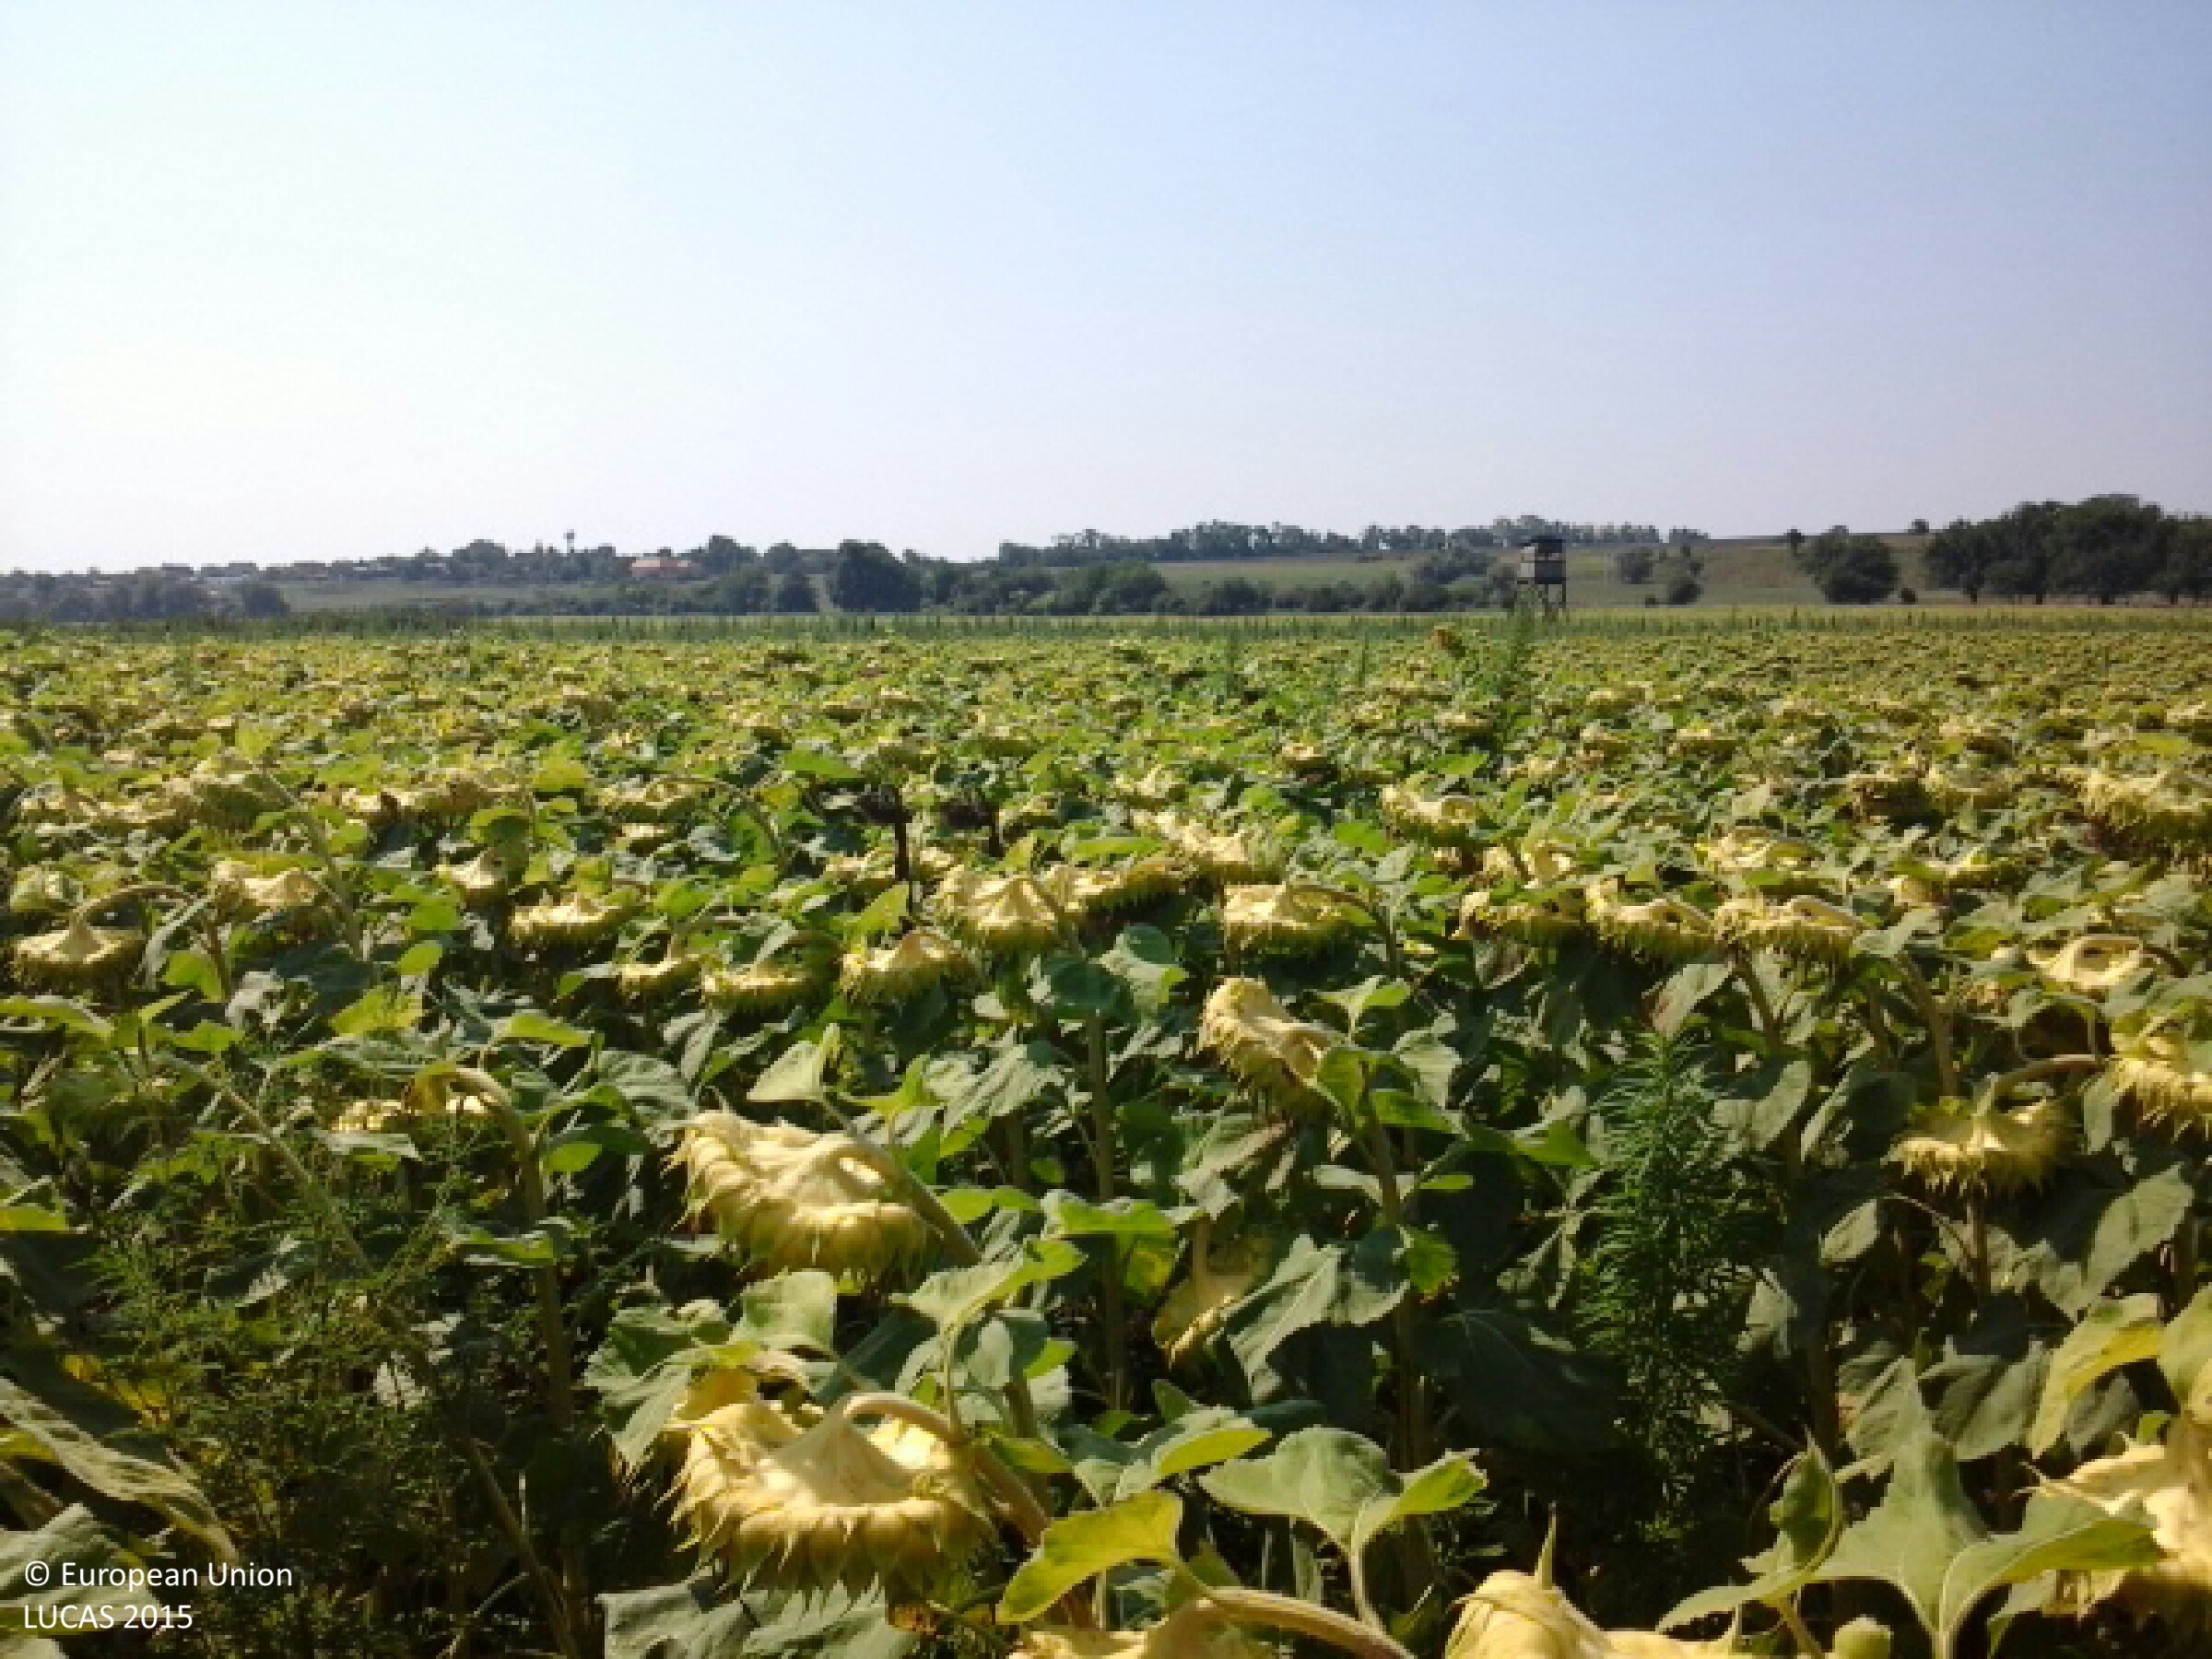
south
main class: Cropland
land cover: Sunflower
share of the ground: > 75 %
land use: Agriculture (excluding fallow land and kitchen gardens)
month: August
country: HU
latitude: 47.4414
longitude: 18.5137
